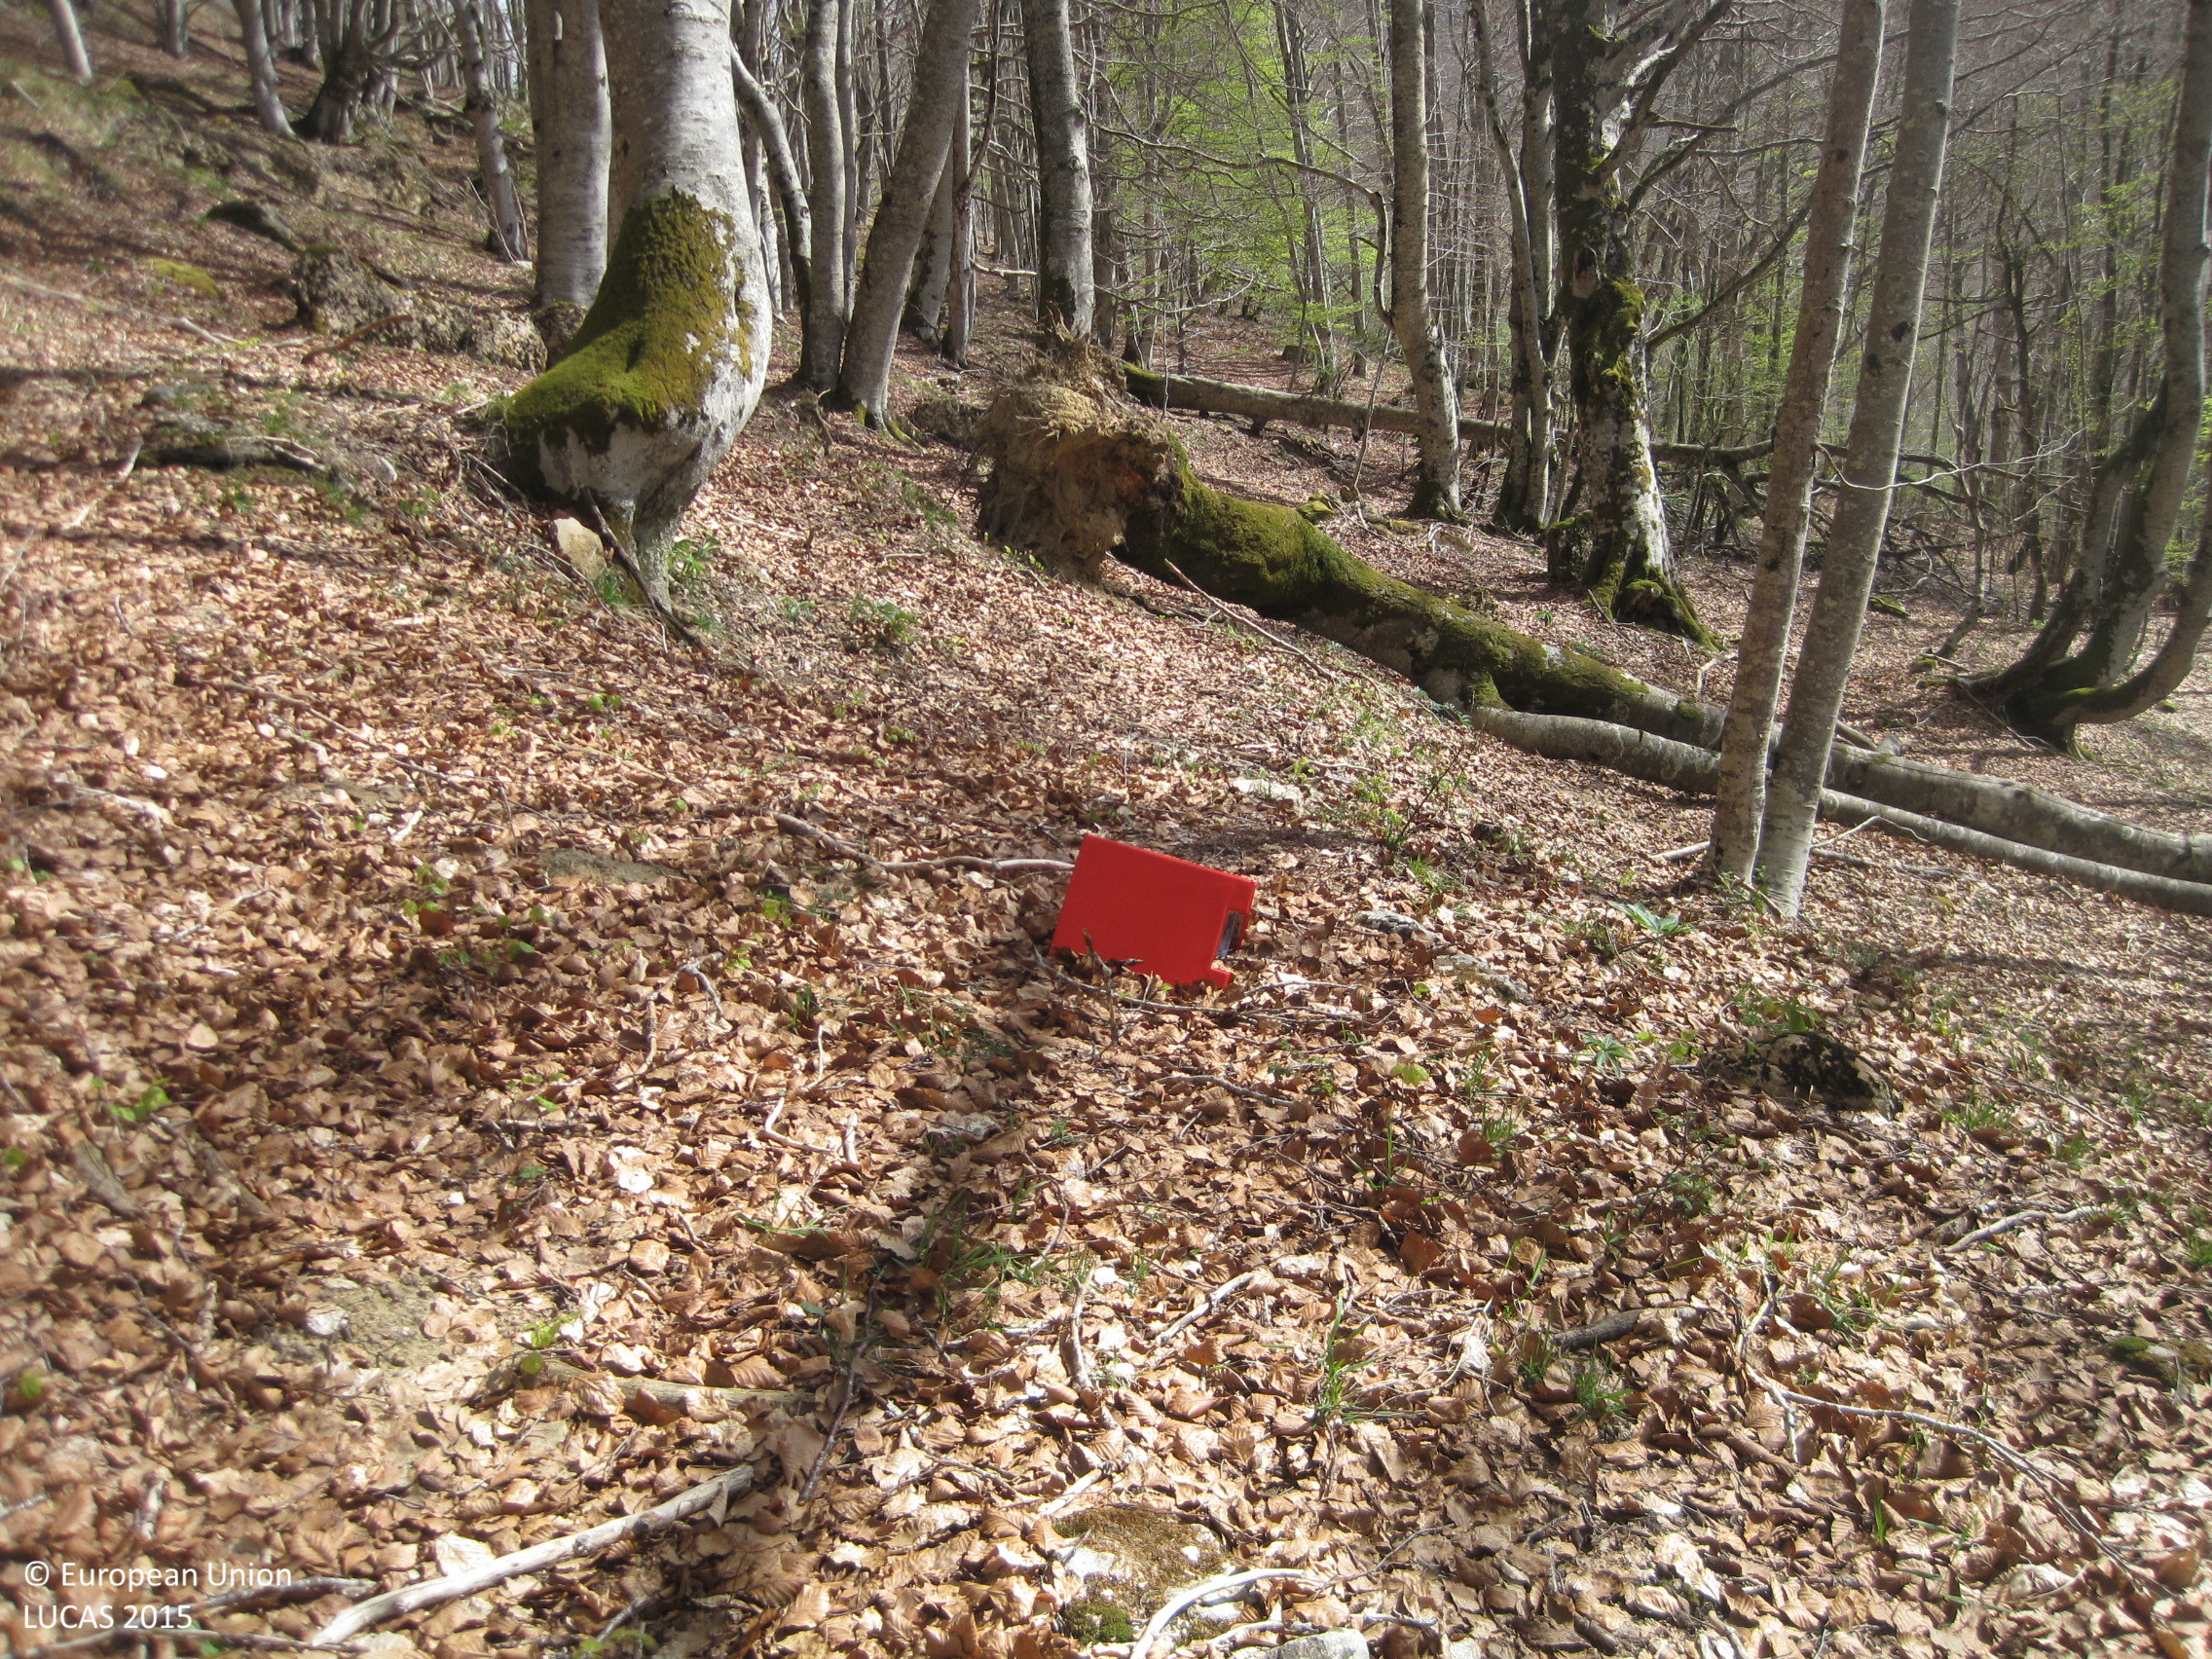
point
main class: Woodland
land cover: Broadleaved woodland
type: beech forest
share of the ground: > 75 %
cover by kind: broadleaved forest trees 100 %
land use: Forestry
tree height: > 5 m
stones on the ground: < 10 %
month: April
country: ES
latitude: 42.7734
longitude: -2.3294
